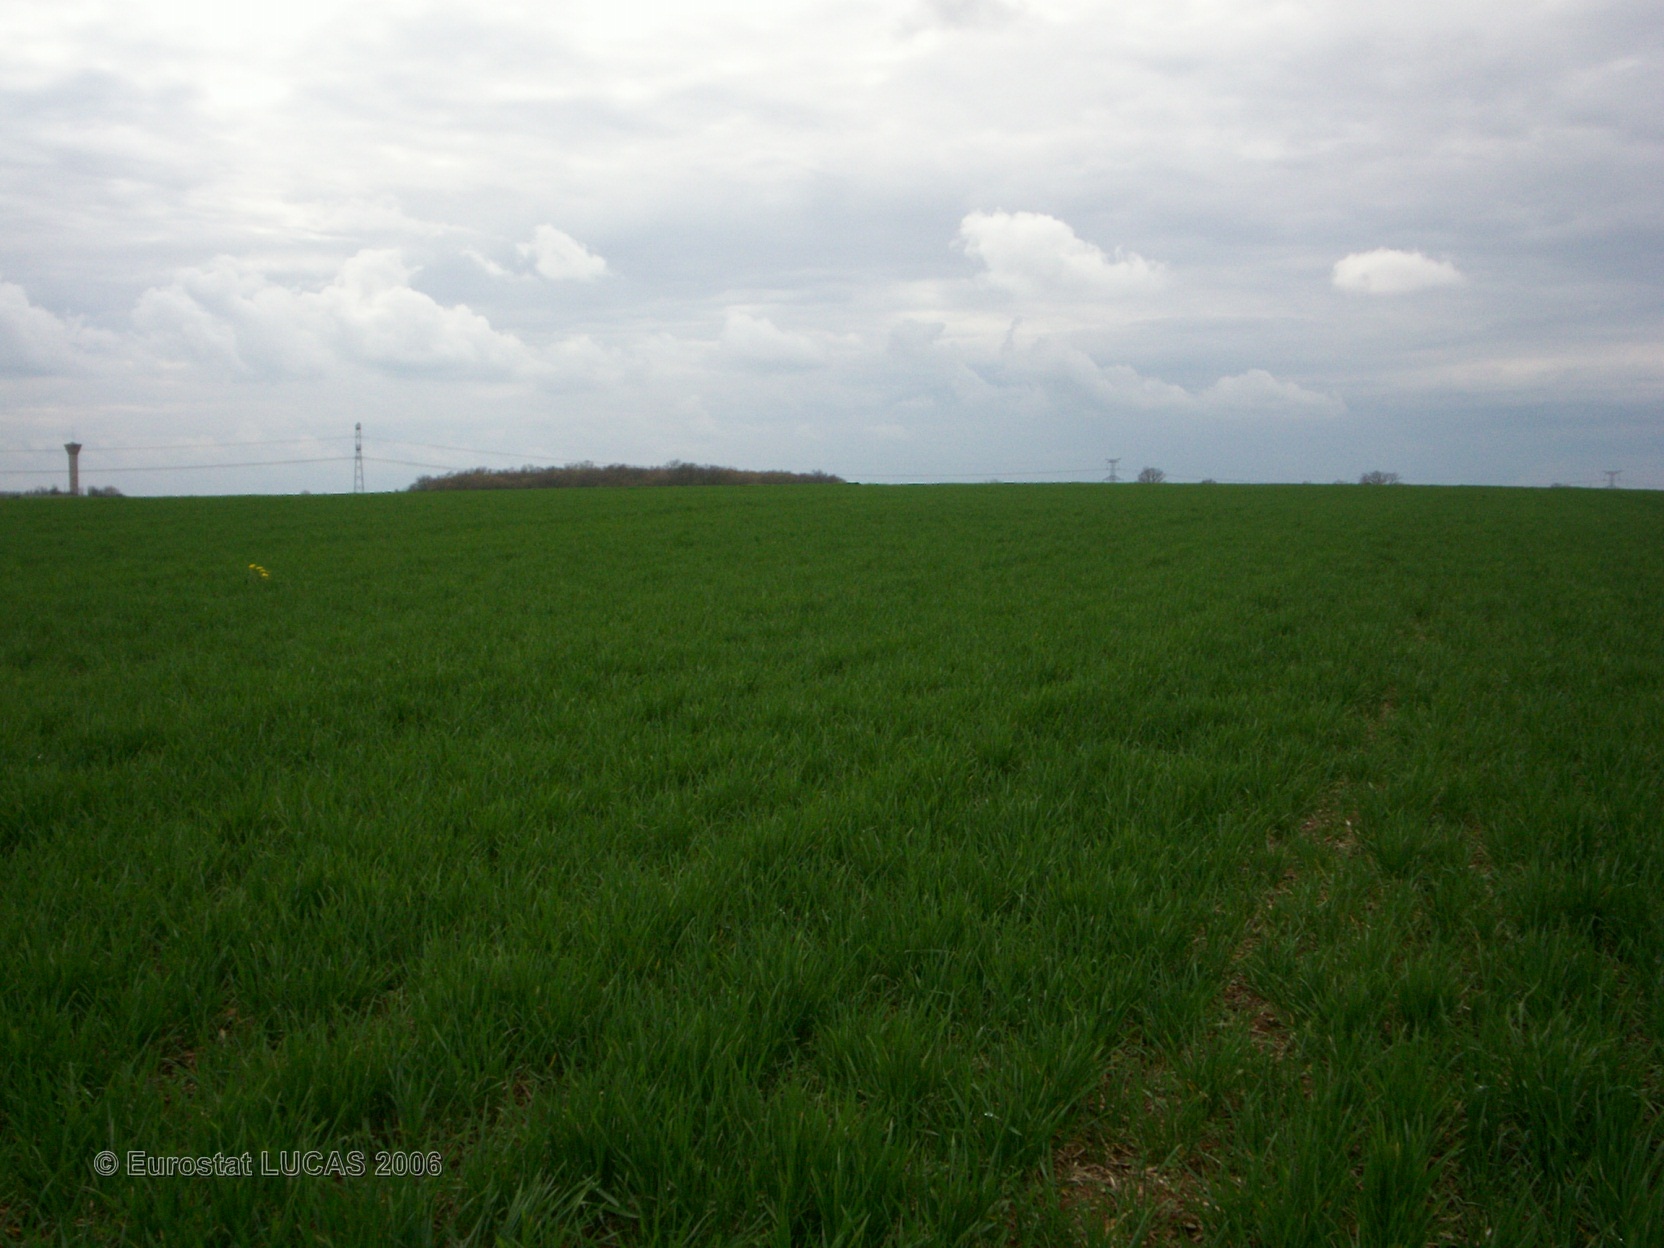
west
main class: Cropland
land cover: Common wheat
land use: Agriculture (excluding fallow land and kitchen gardens)
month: April
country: FR
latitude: 47.4414
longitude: 3.0062
